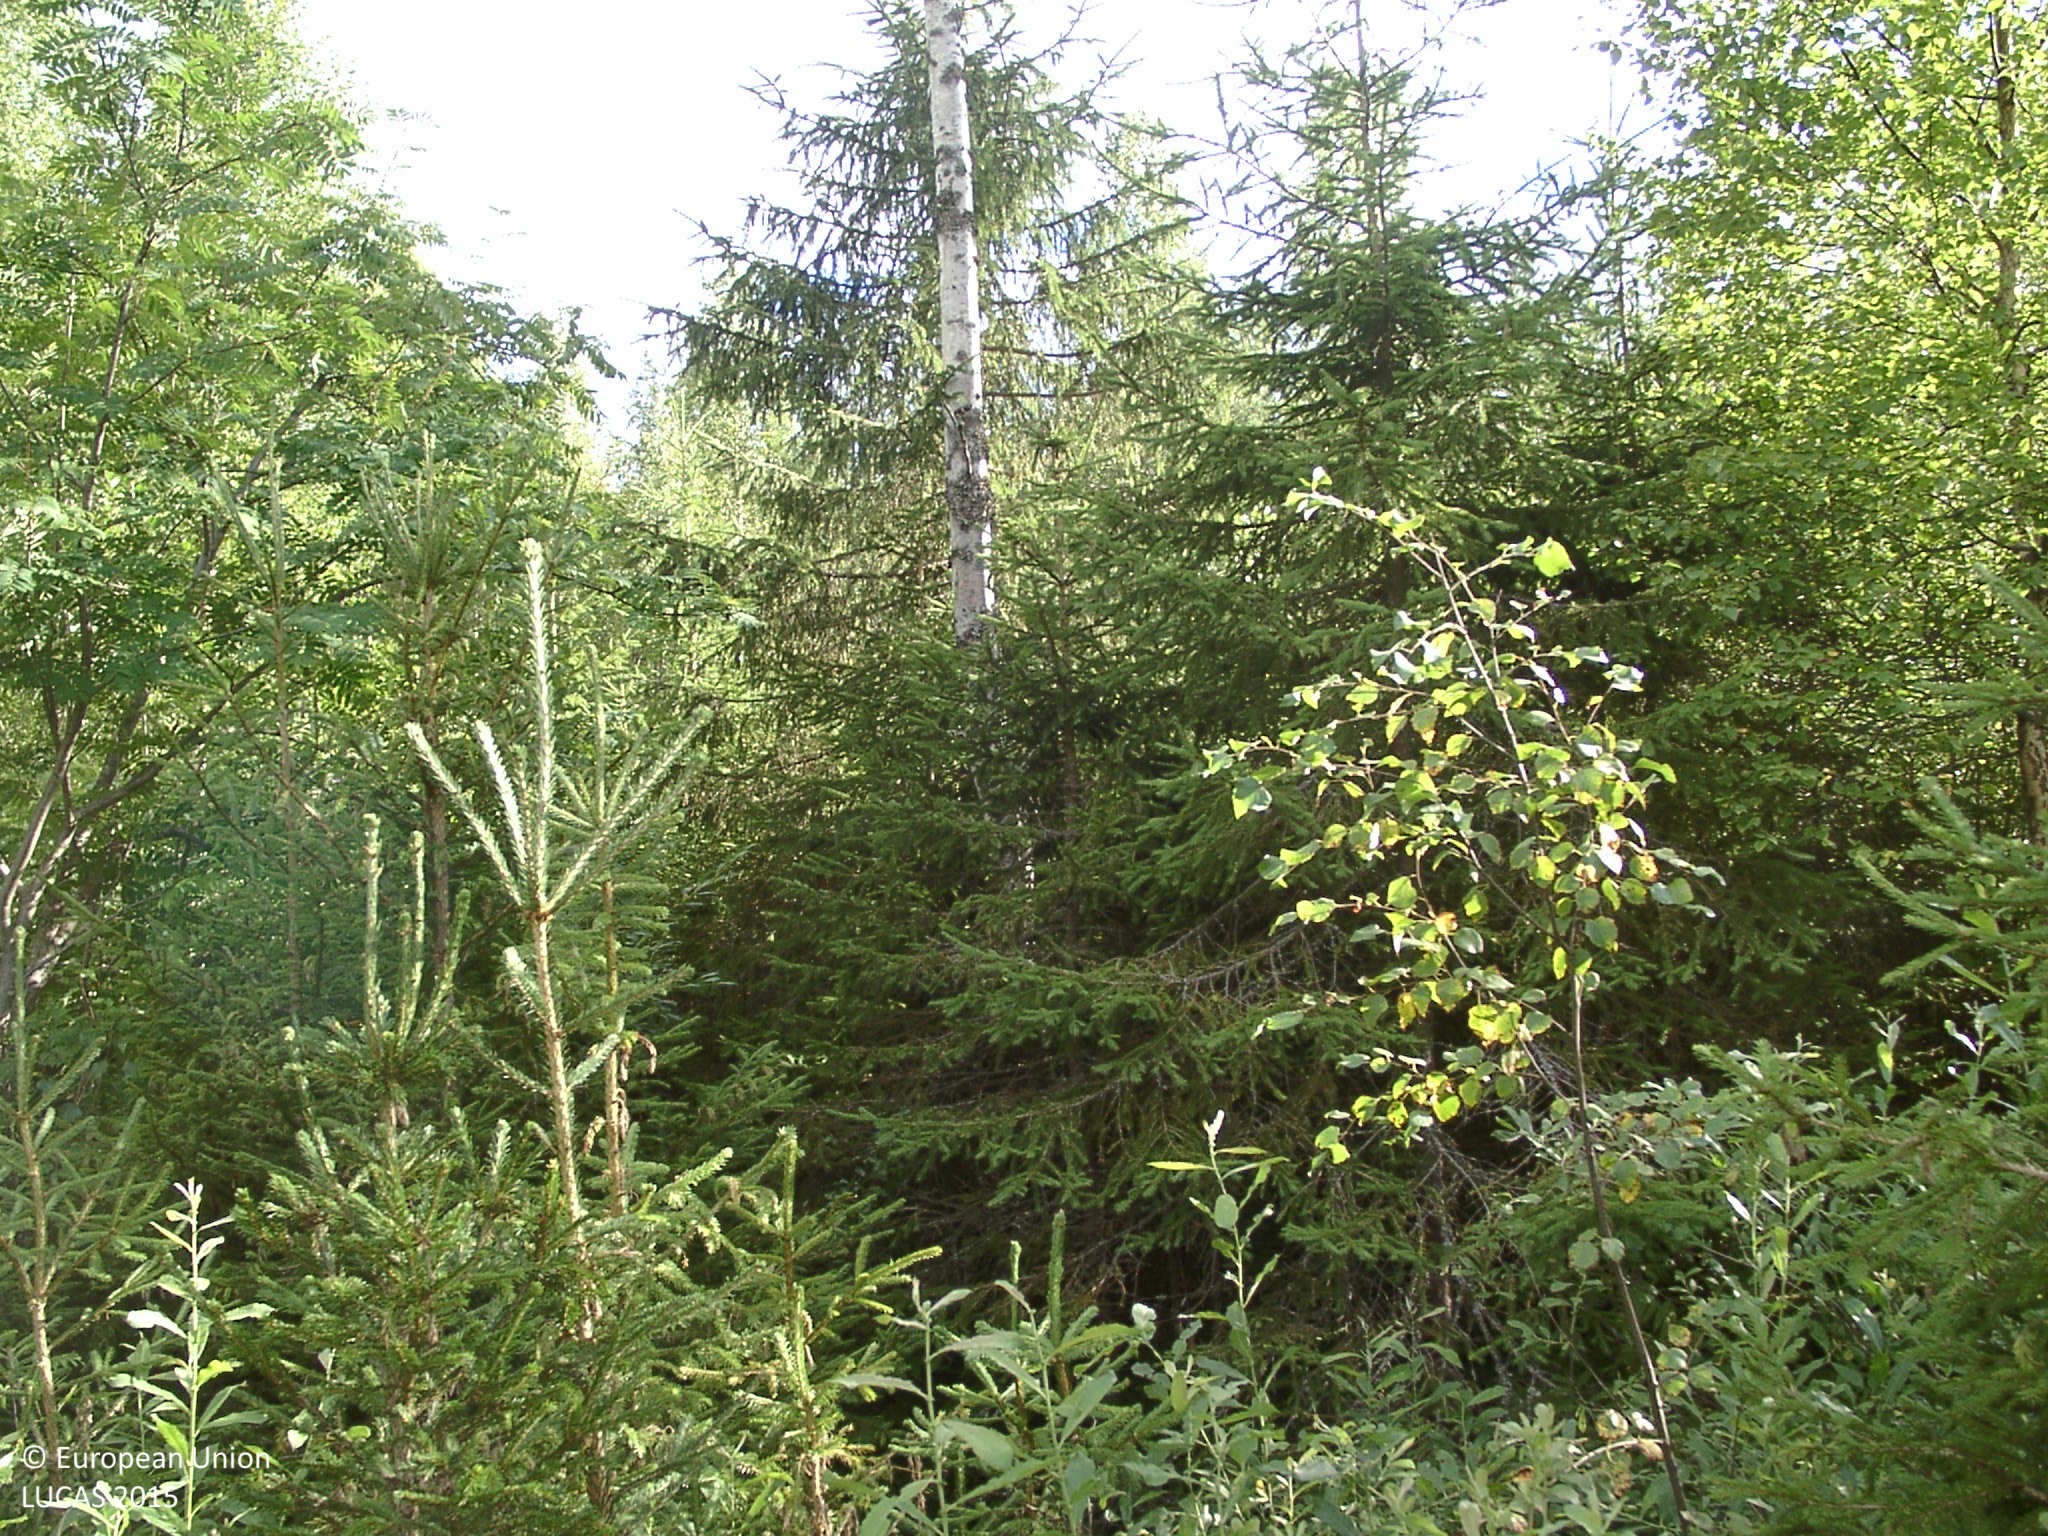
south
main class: Woodland
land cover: Broadleaved woodland
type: boreal forest
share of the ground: 25 - 50 %
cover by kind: shrubs 40 %, herbaceous plants 30 %, broadleaved forest trees 25 %, coniferous forest trees 5 %
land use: Forestry
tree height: < 5 m
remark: Nursery
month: August
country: FI
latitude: 62.3681
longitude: 25.5570
